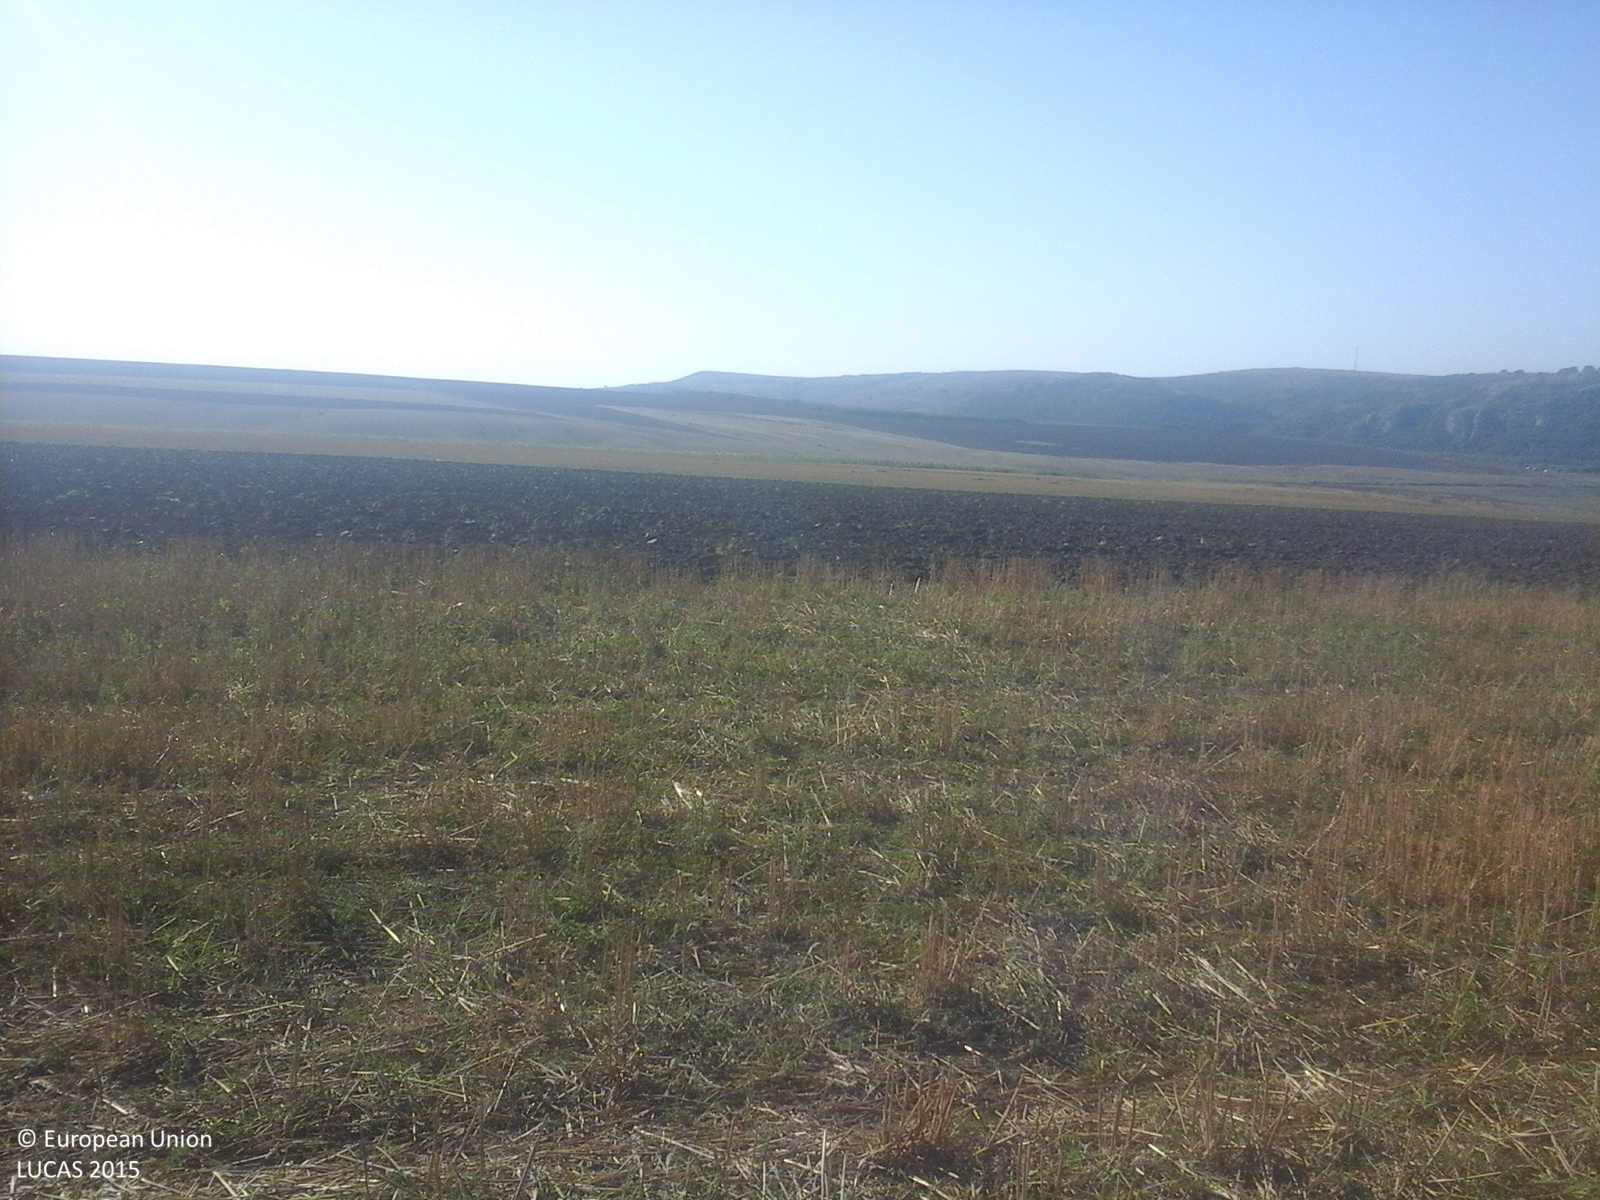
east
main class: Cropland
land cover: Common wheat
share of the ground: > 75 %
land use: Agriculture (excluding fallow land and kitchen gardens)
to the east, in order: Common wheat; Other leguminous and mixtures for fodder; Durum wheat
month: August
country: RO
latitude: 44.5067
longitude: 28.4486
